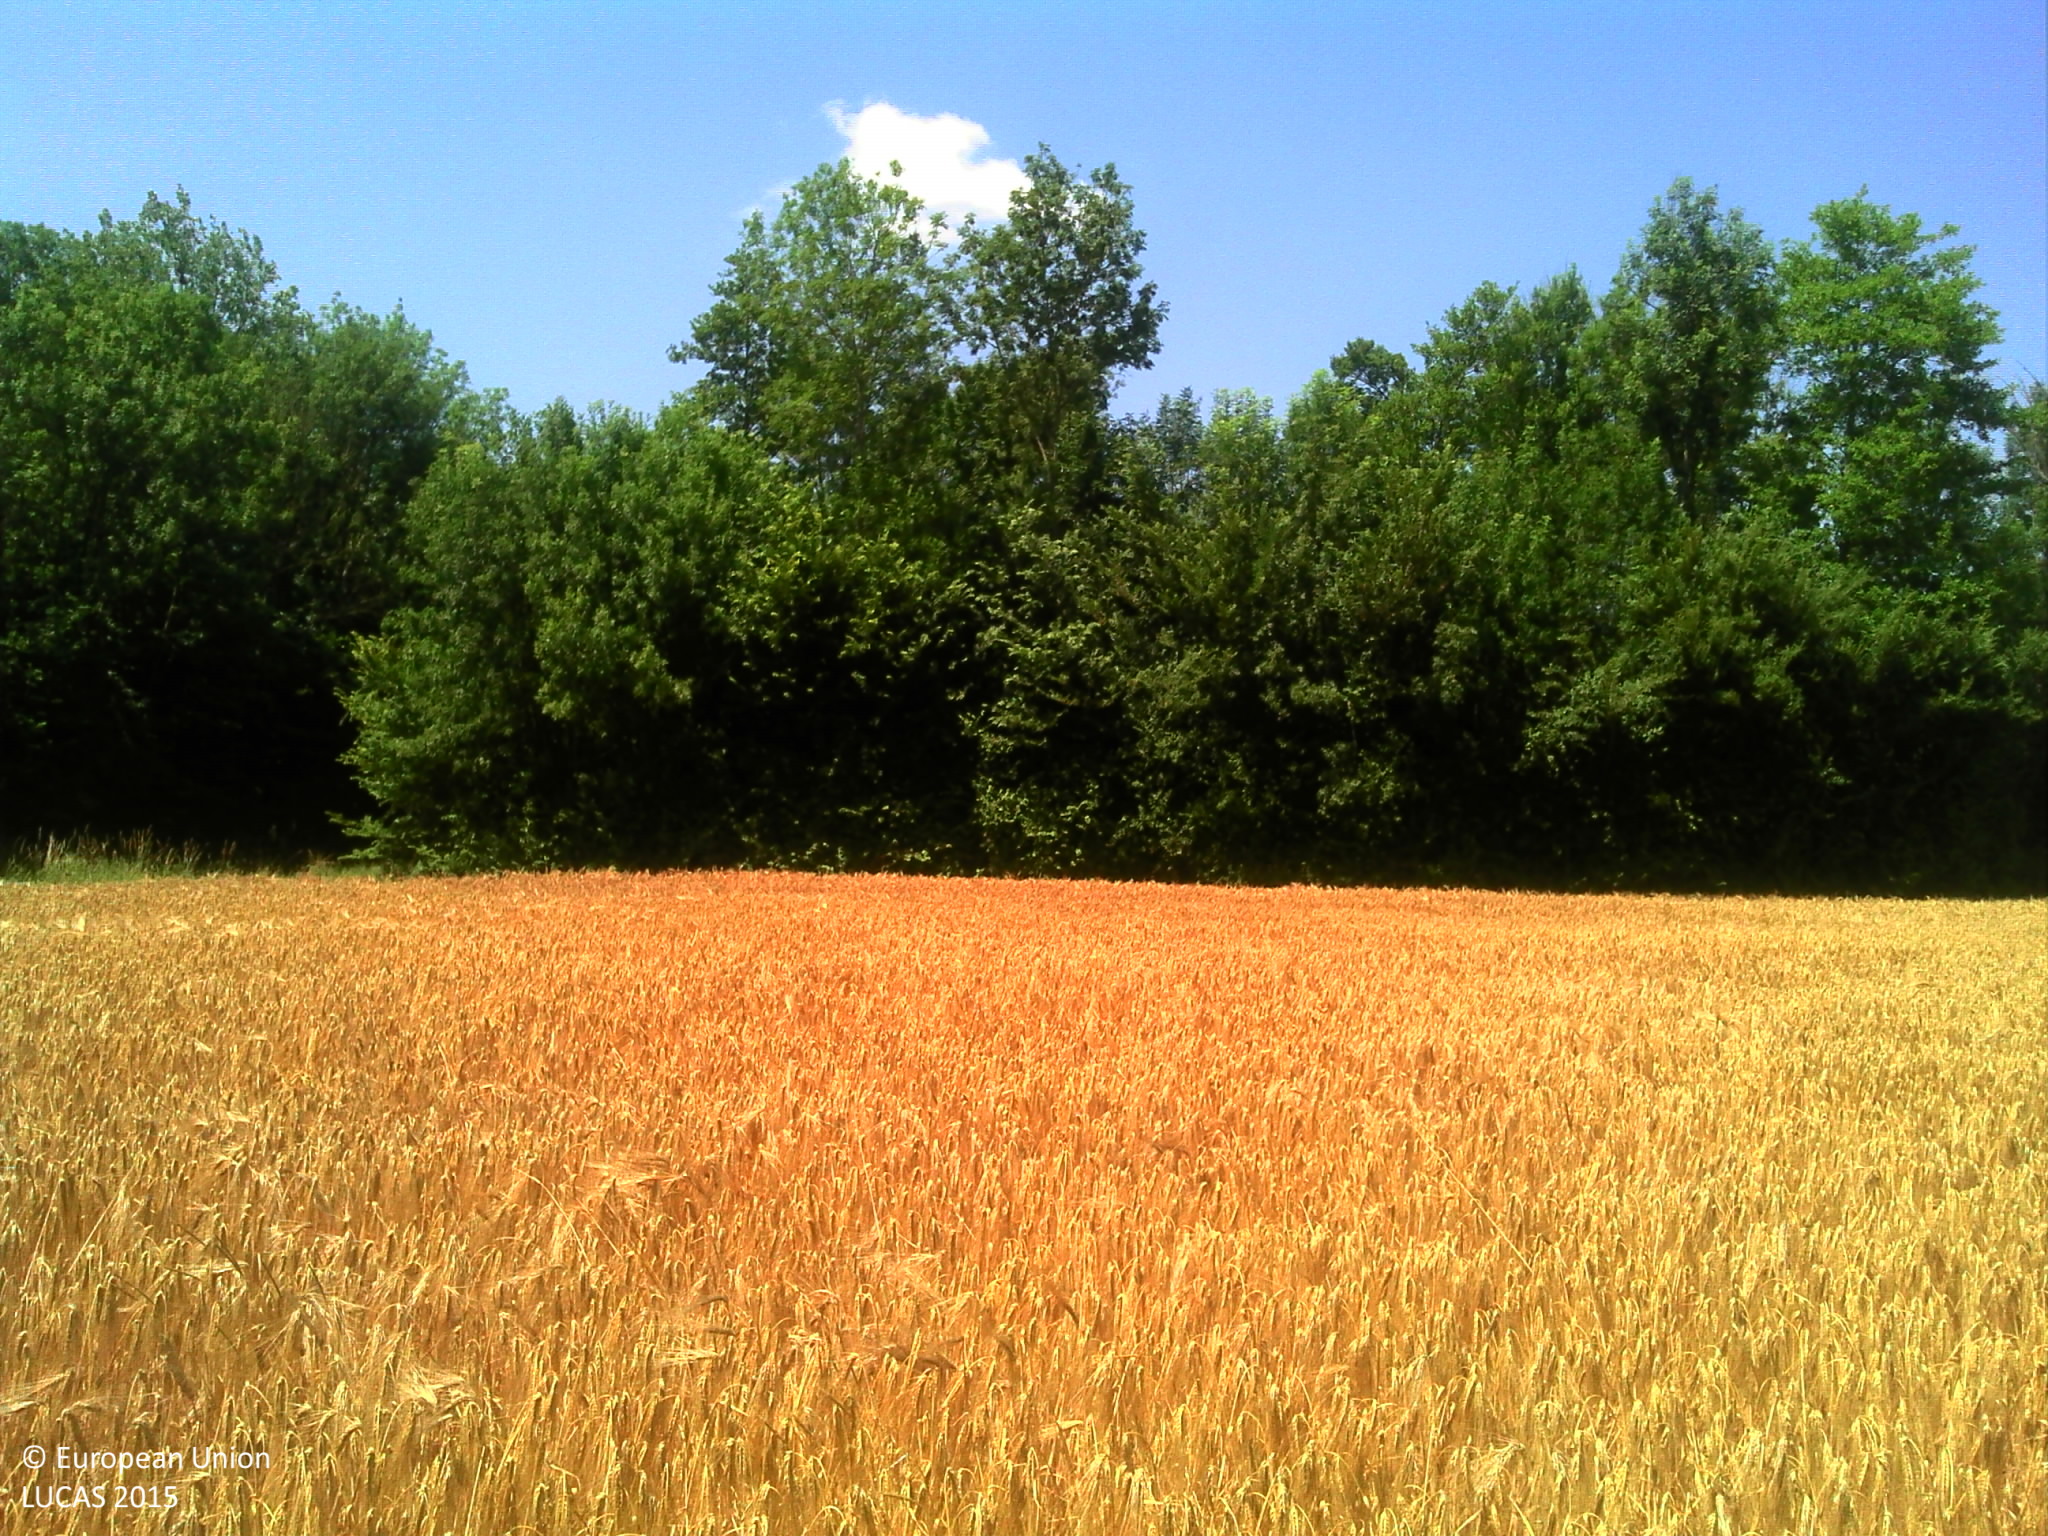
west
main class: Cropland
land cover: Barley
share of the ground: > 75 %
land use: Agriculture (excluding fallow land and kitchen gardens)
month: June
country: FR
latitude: 47.1136
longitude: 5.2963
